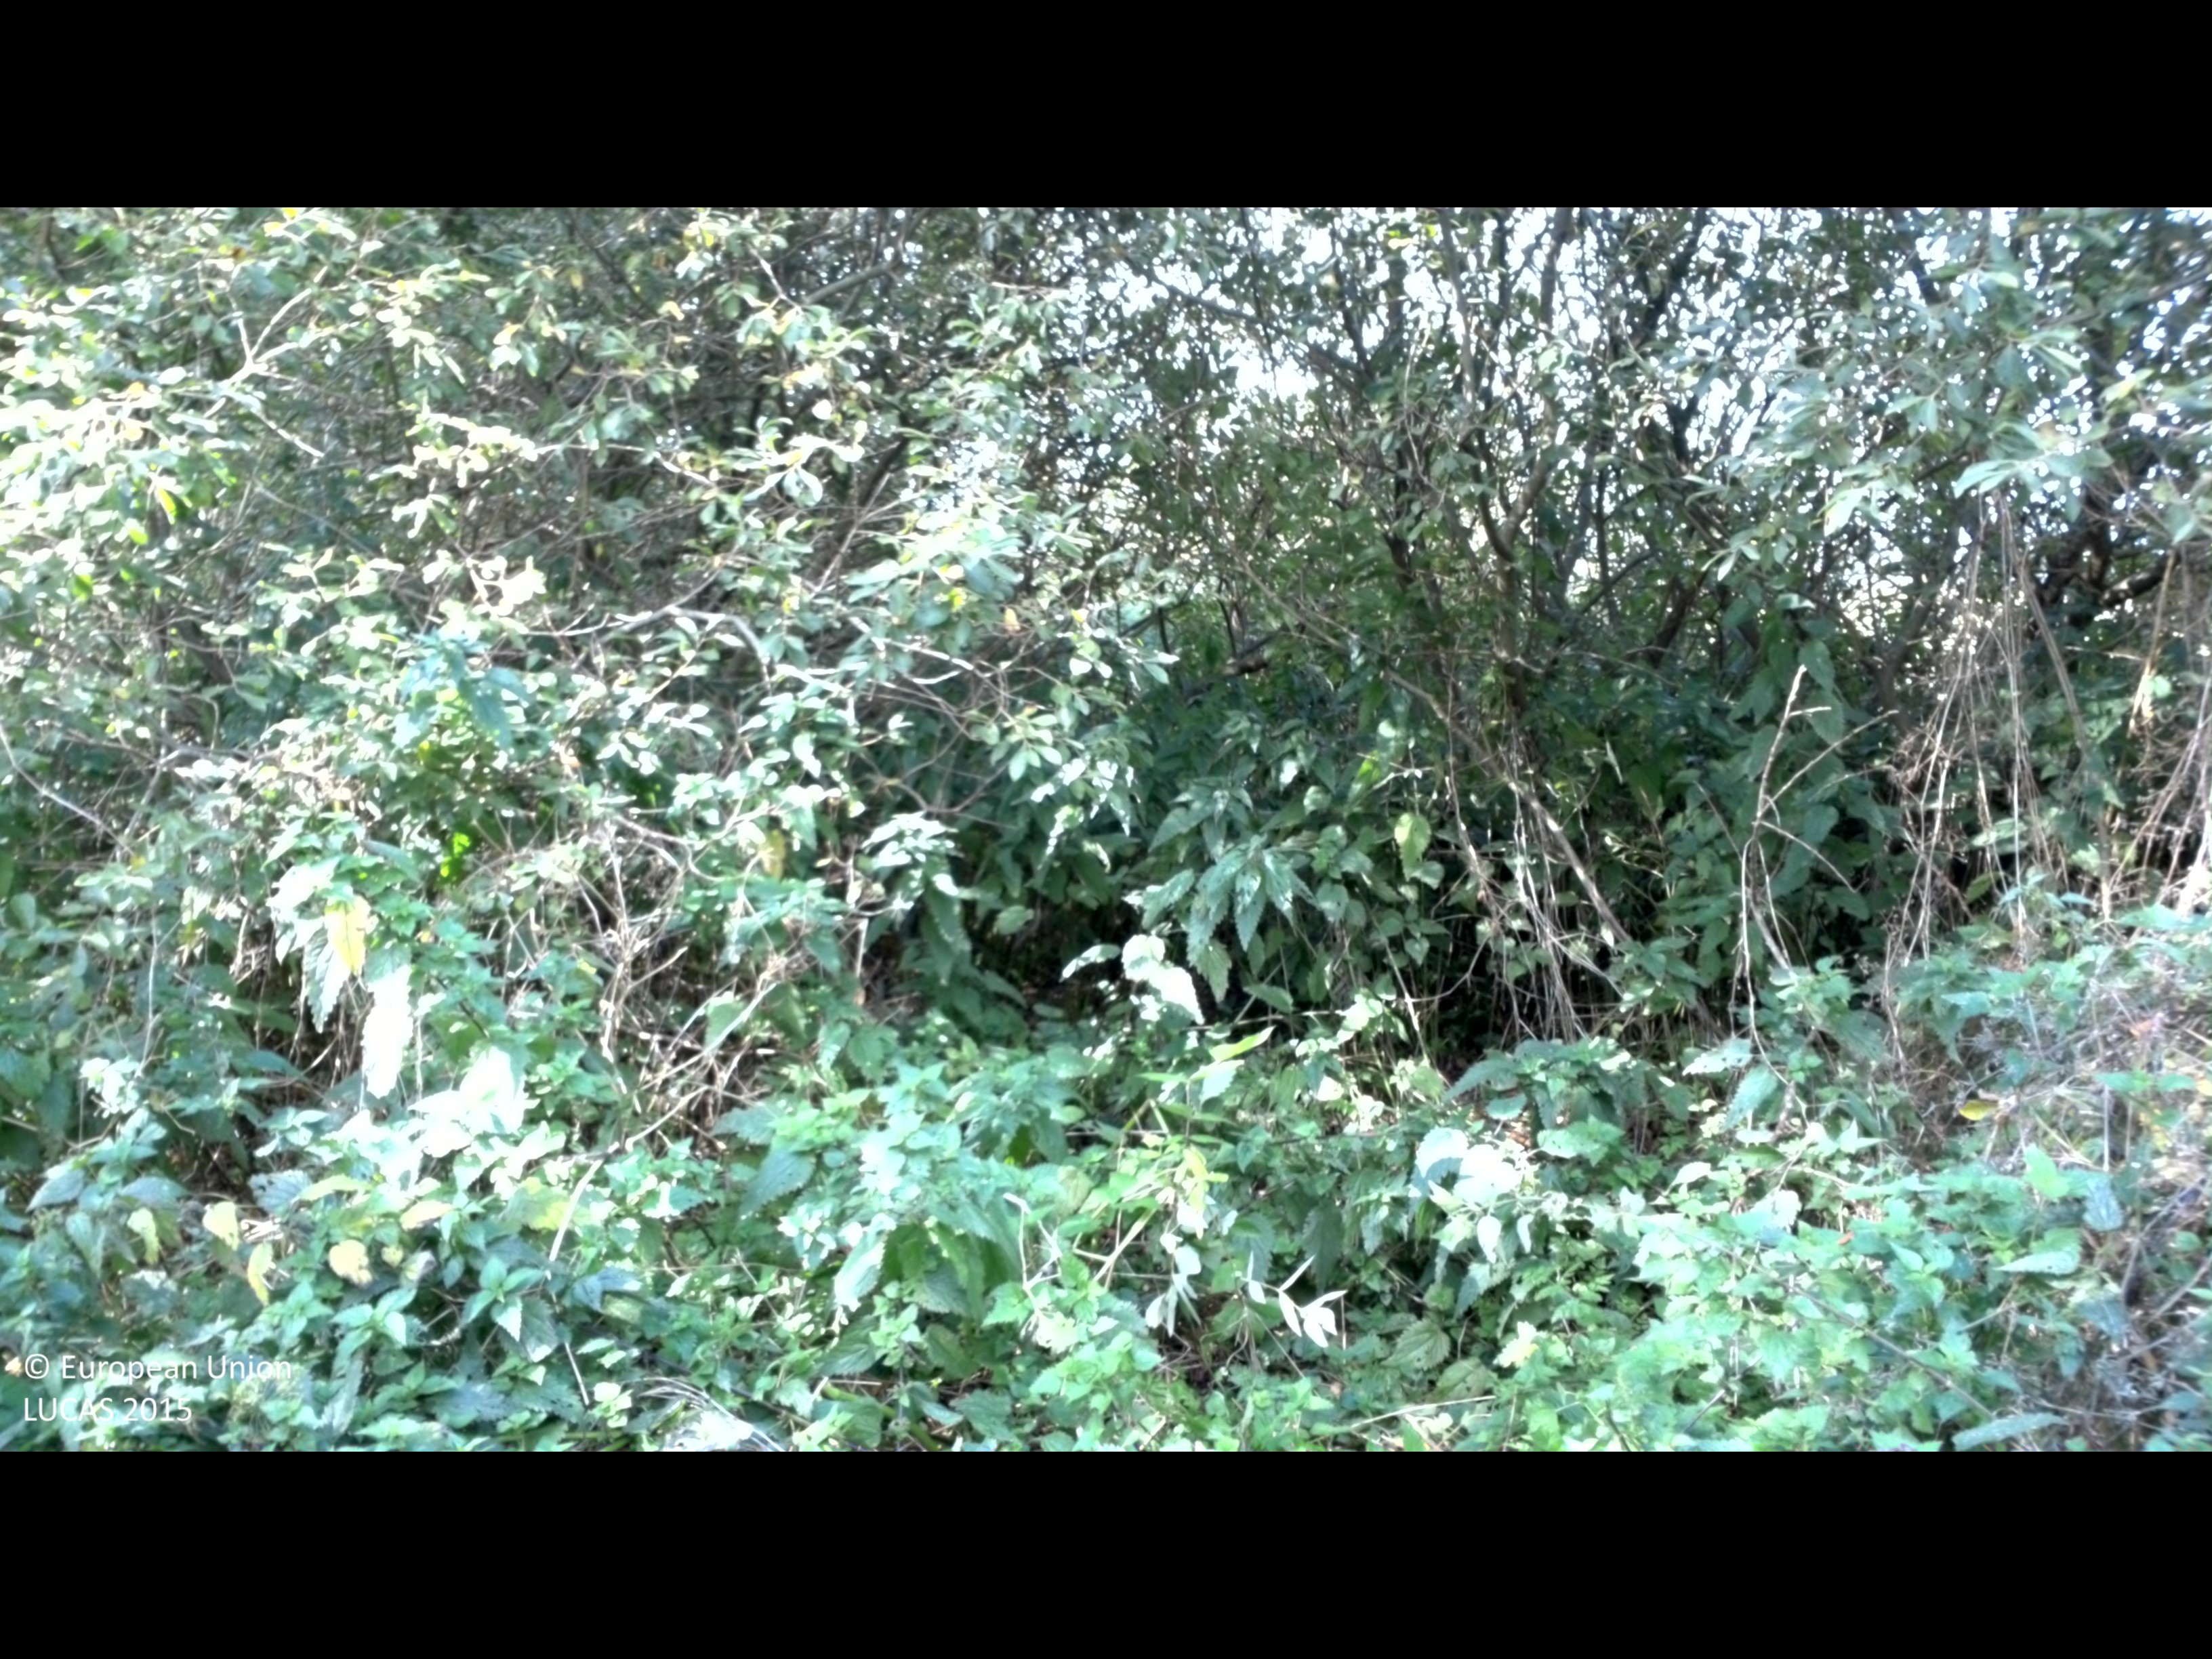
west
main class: Woodland
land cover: Broadleaved woodland
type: hemiboreal forest and nemoral coniferous forest and mixed broadleaved-coniferous forest
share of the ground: > 75 %
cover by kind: broadleaved forest trees 75 %, herbaceous plants 25 %
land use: Forestry
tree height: < 5 m
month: September
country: SE
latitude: 56.0242
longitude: 14.3462
